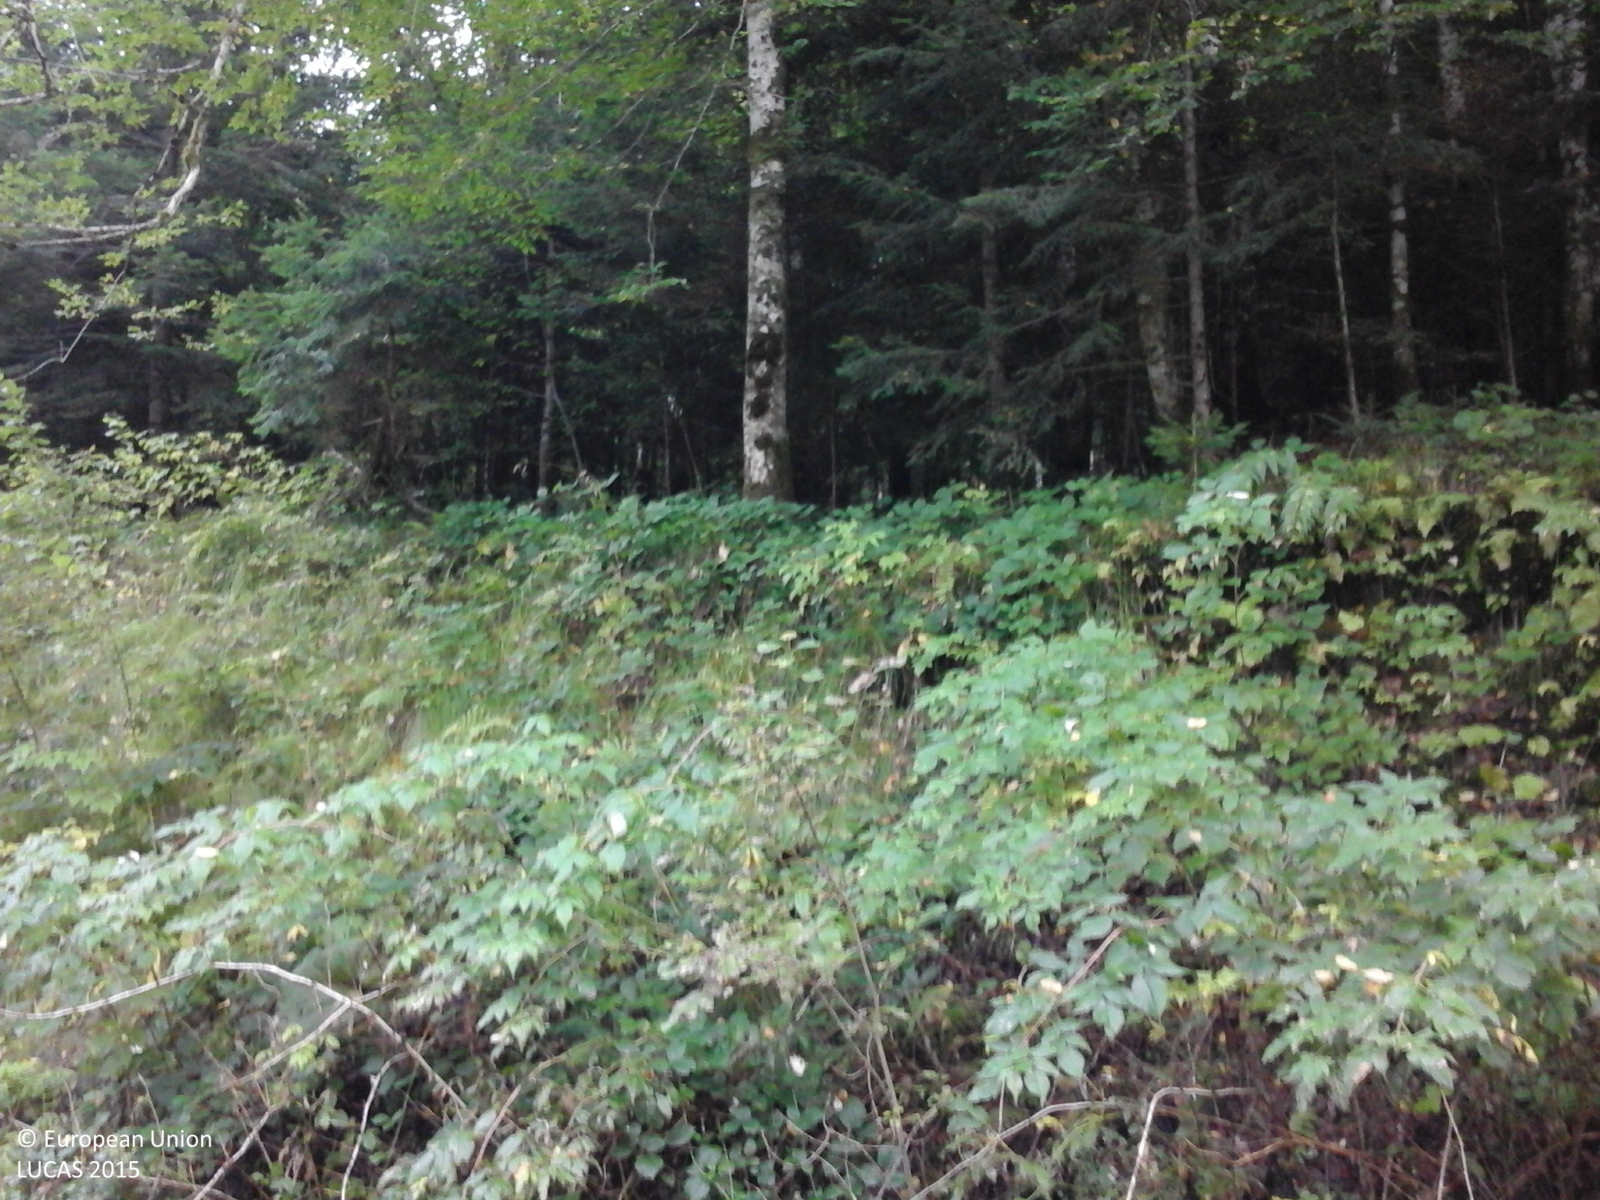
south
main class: Woodland
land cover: Spruce dominated mixed woodland
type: alpine coniferous forest
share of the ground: 50 - 75 %
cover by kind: coniferous forest trees 60 %, broadleaved forest trees 40 %
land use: Forestry
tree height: > 5 m
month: September
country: RO
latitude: 45.3870
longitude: 22.5752
